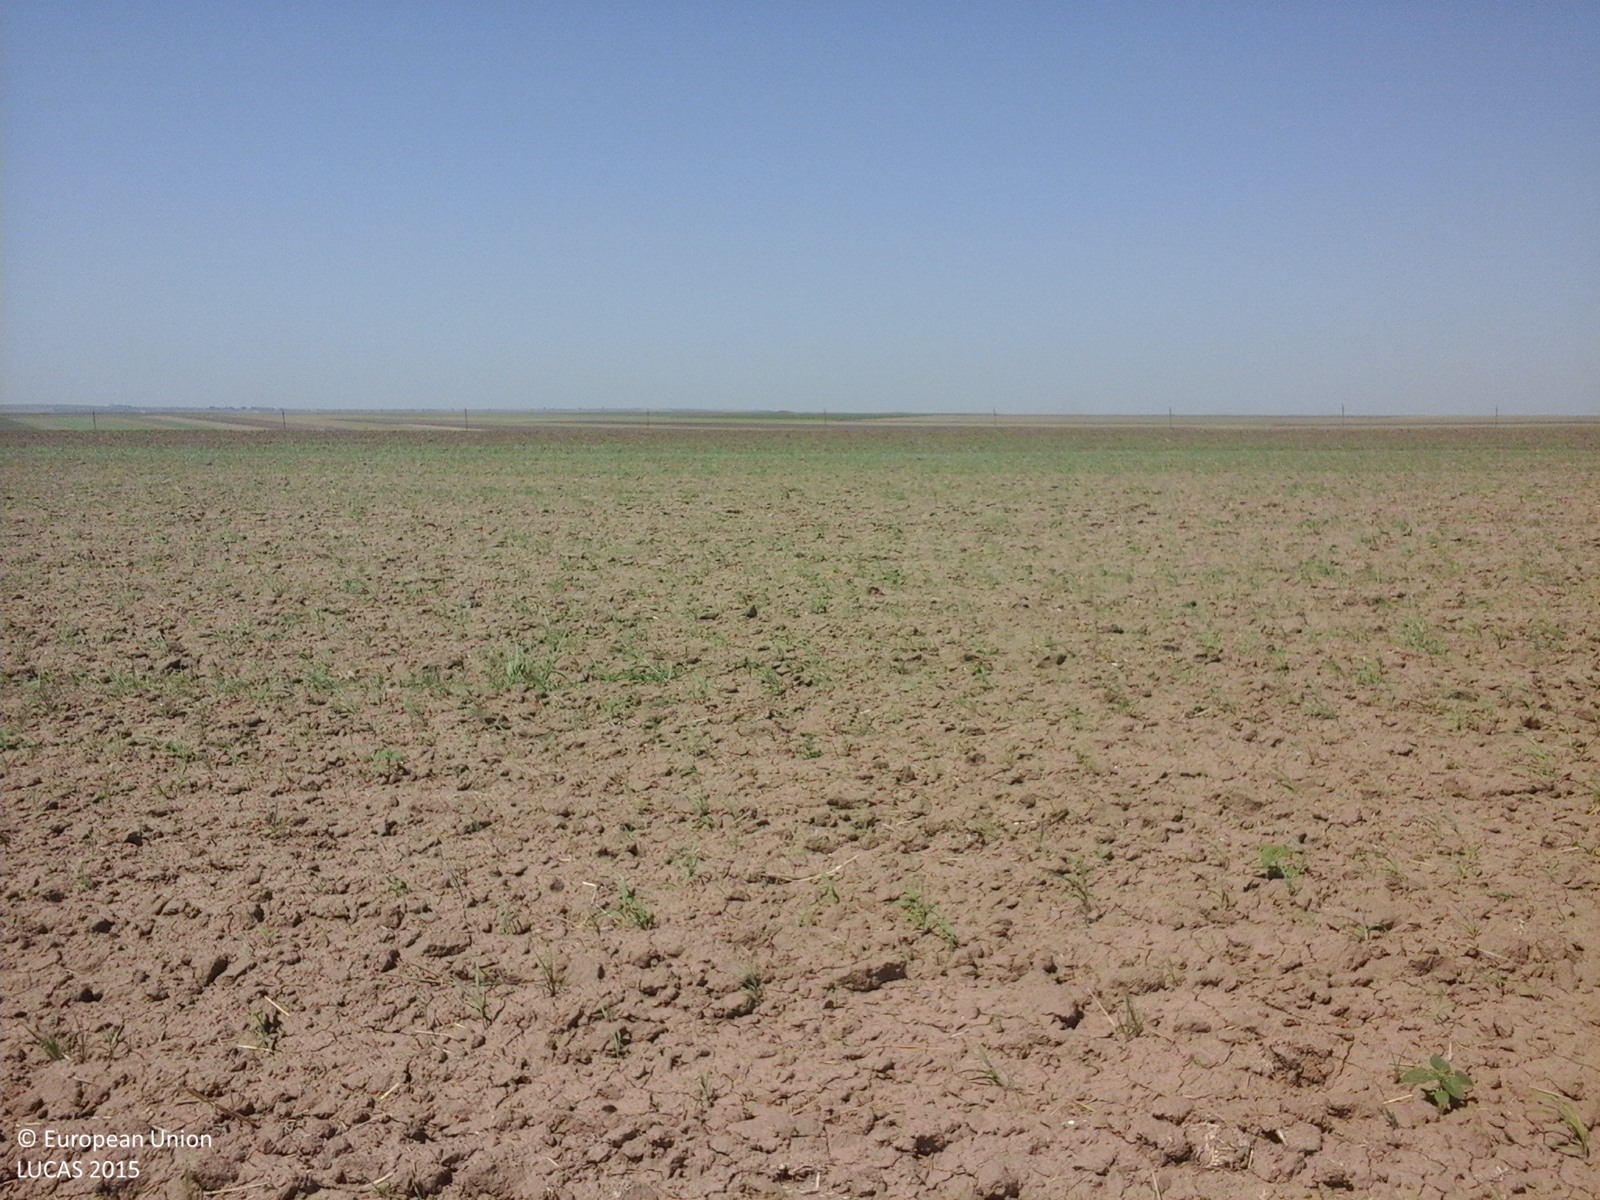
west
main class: Cropland
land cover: Durum wheat
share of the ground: < 10 %
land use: Agriculture (excluding fallow land and kitchen gardens)
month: August
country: RO
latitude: 44.5807
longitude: 28.4474
